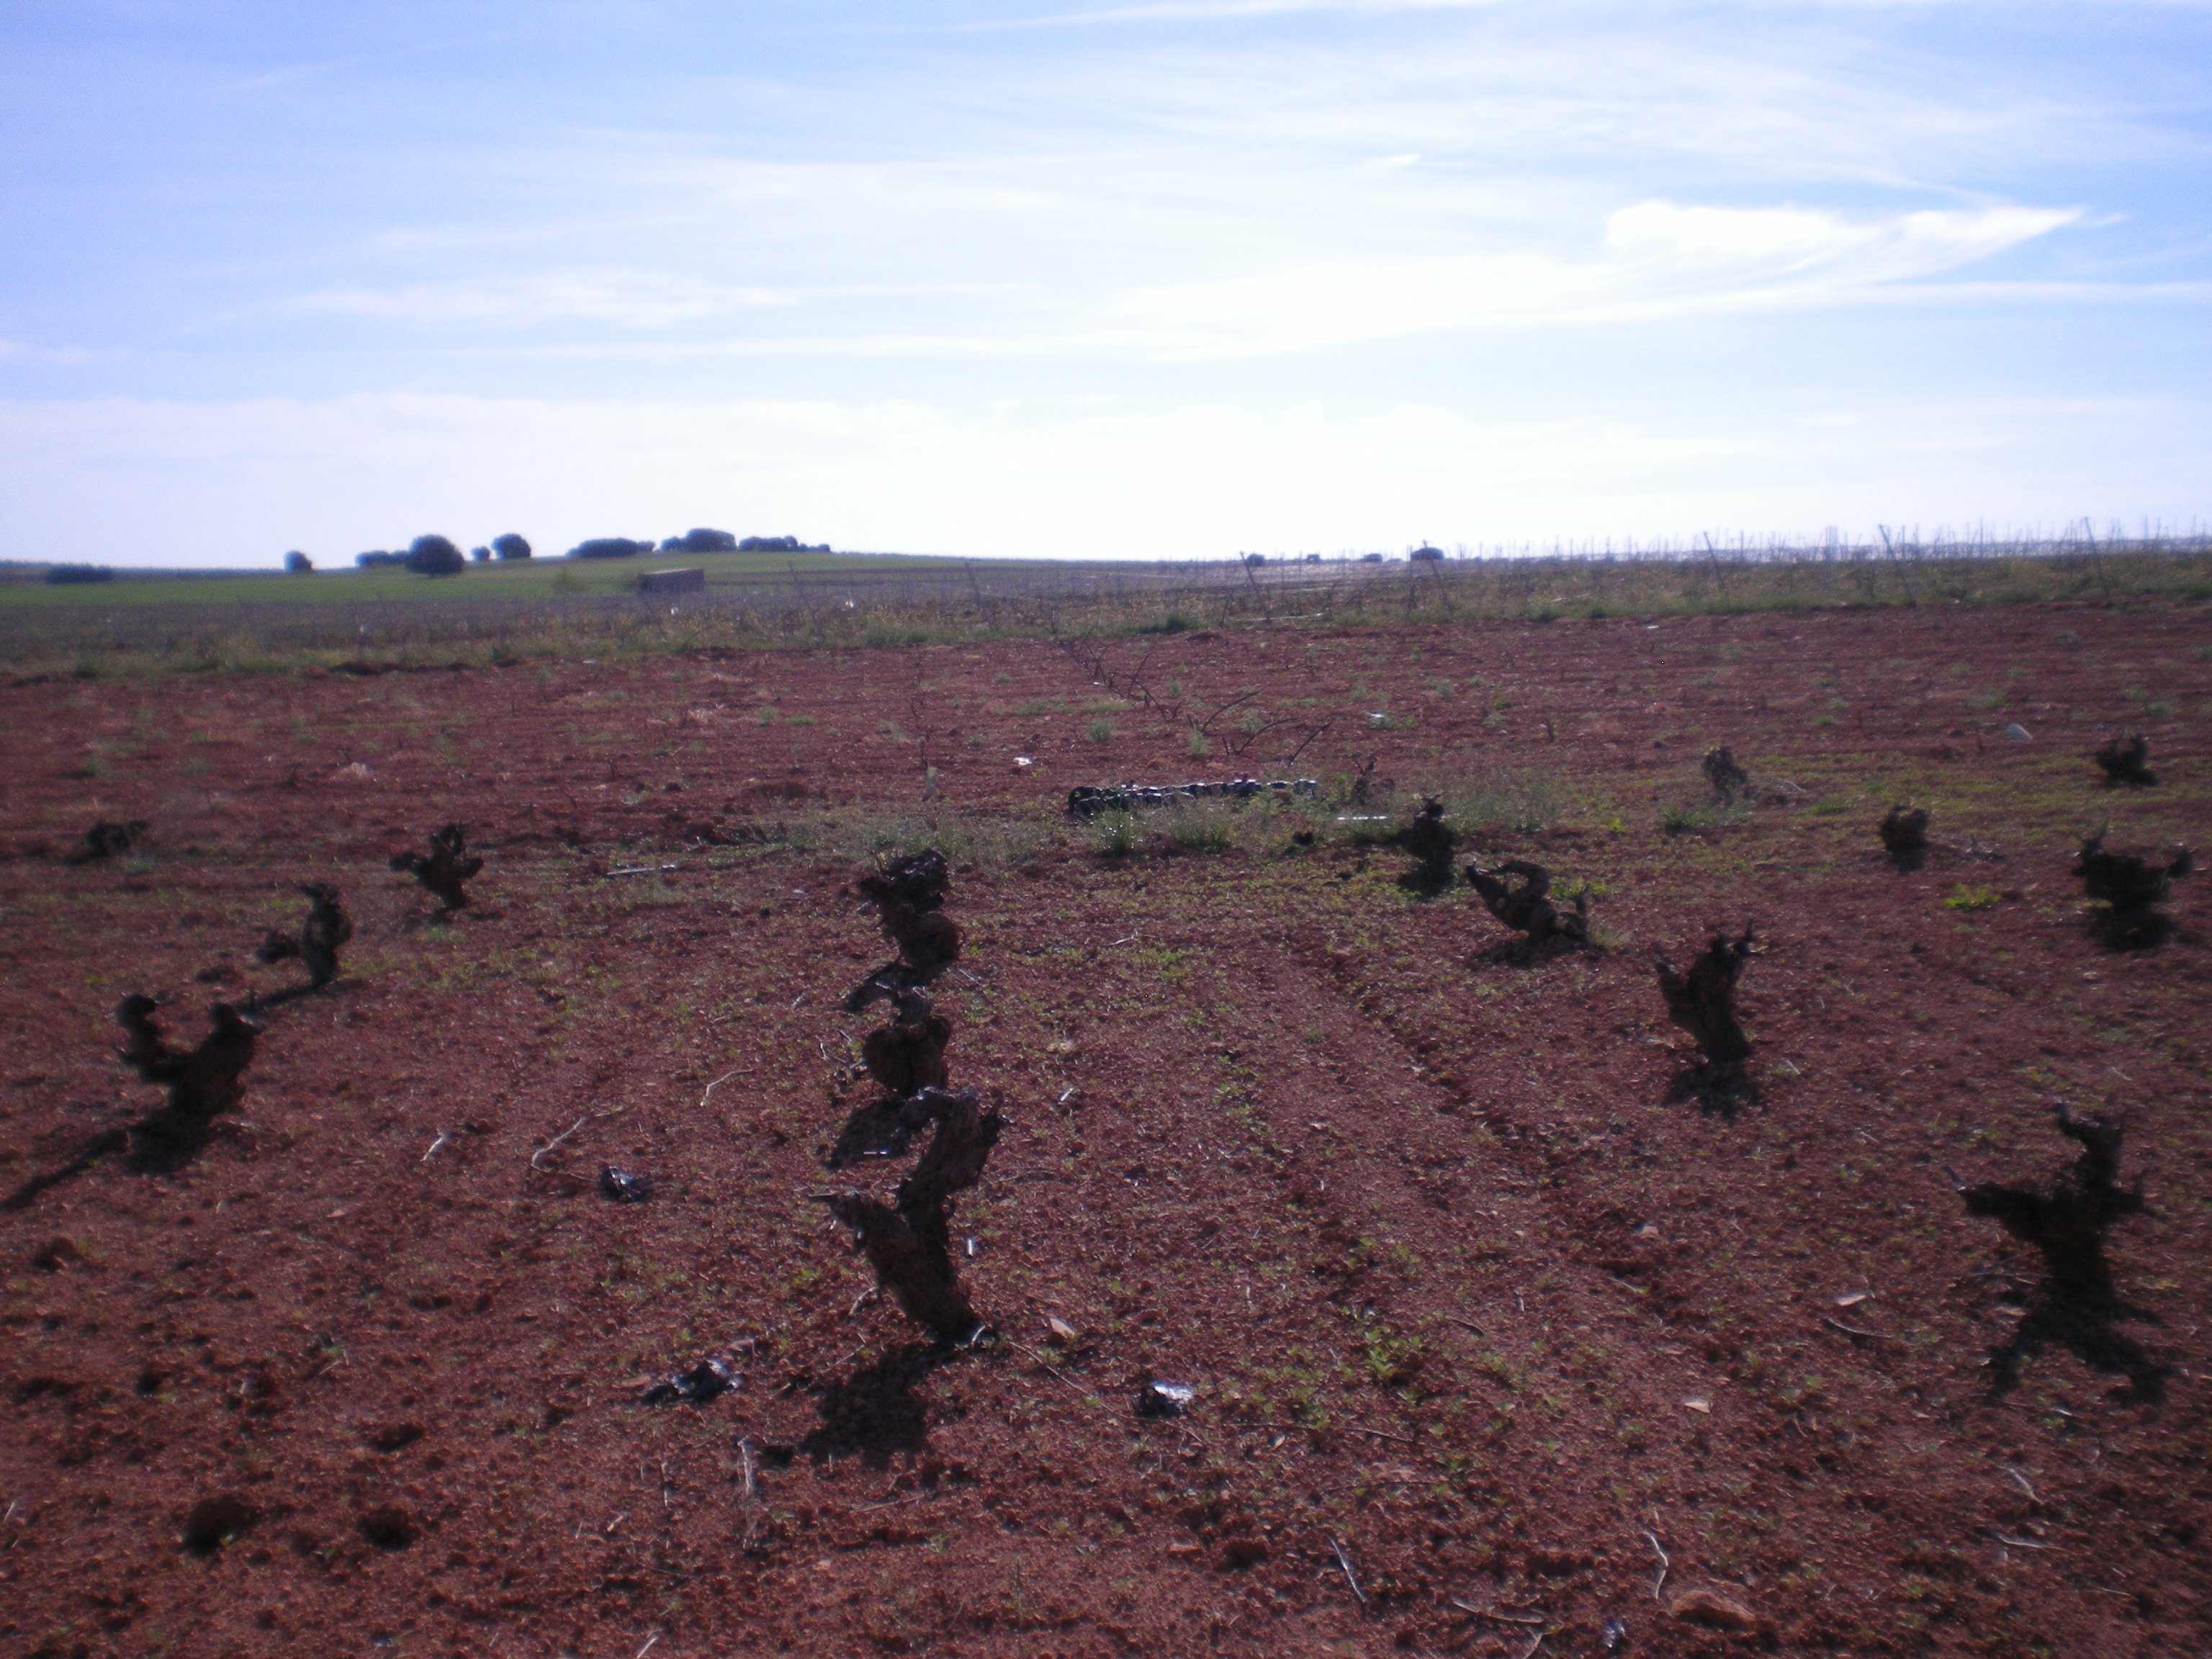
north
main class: Cropland
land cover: Vineyards
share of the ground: < 10 %
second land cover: Other bare soil
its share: > 75 %
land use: Agriculture (excluding fallow land and kitchen gardens)
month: April
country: ES
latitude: 38.7863
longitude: -3.1907
